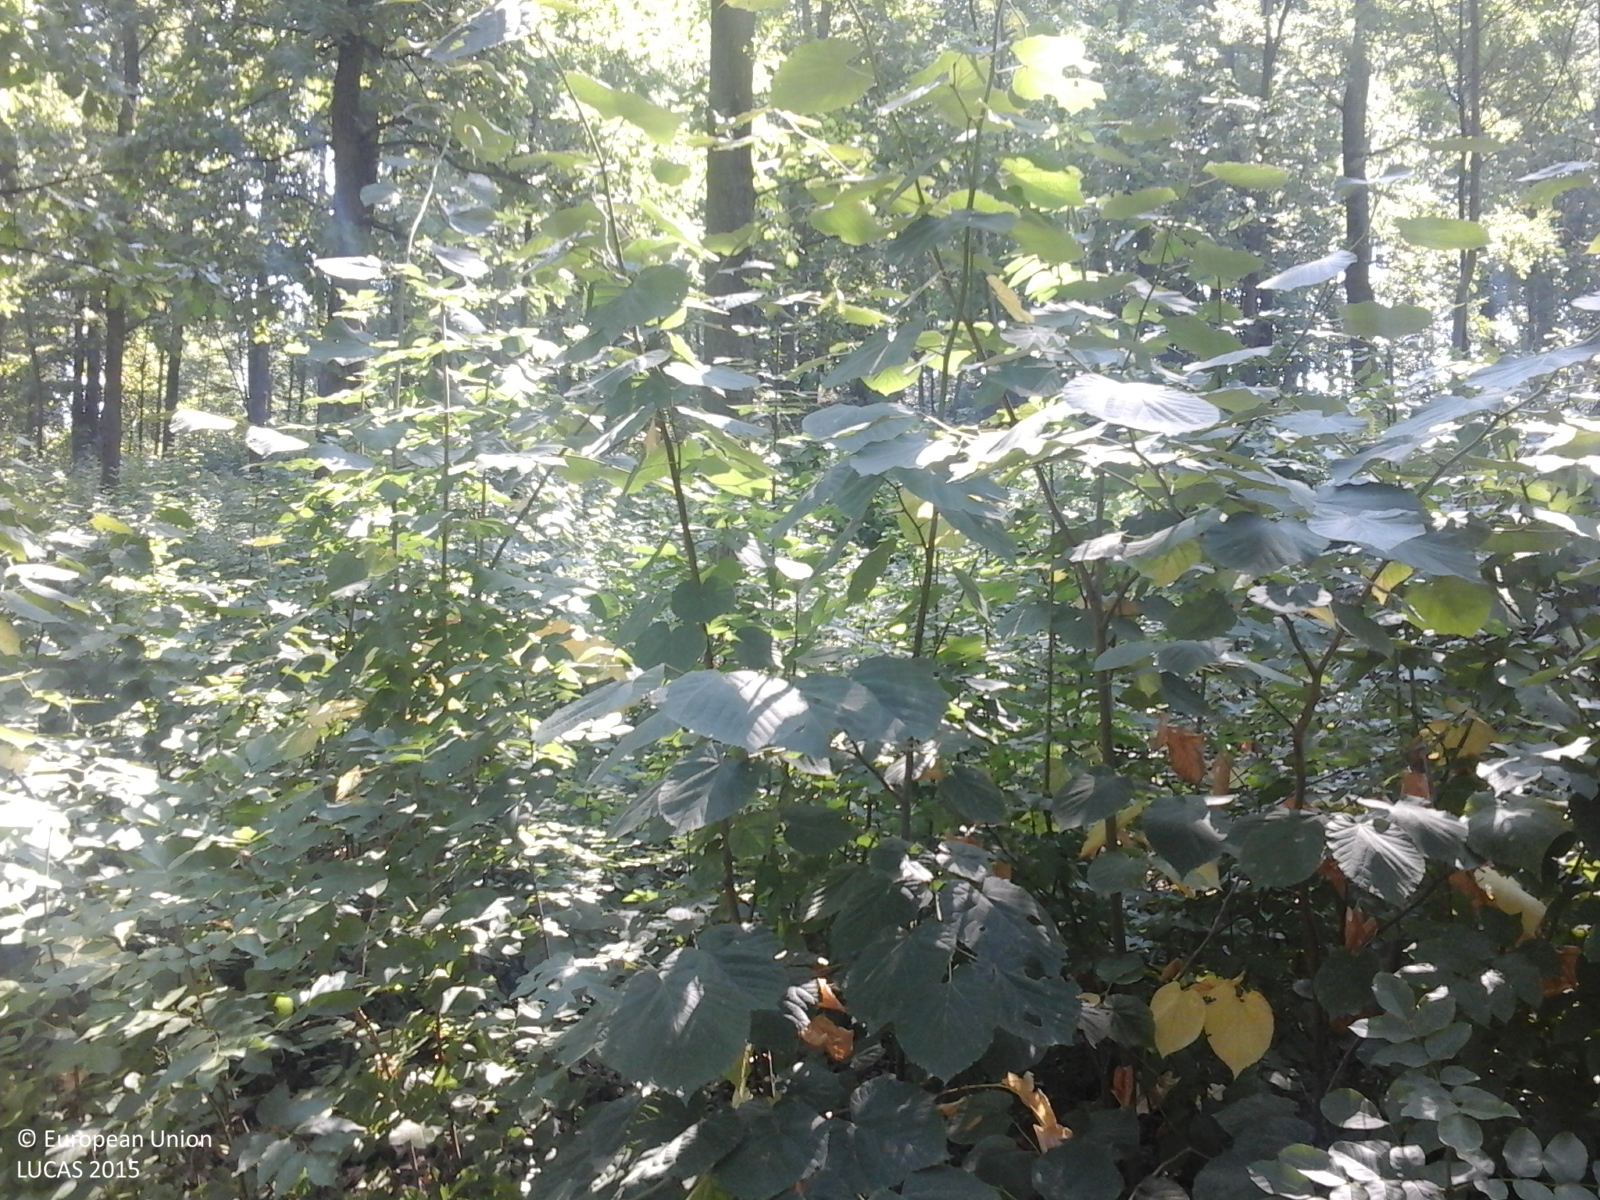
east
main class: Woodland
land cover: Broadleaved woodland
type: acidophilous oak and oak-birch forest
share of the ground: > 75 %
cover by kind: broadleaved forest trees 100 %
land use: Forestry
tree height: > 5 m
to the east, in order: Broadleaved woodland; Tracks; Broadleaved woodland
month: August
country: RO
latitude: 44.5497
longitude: 23.1520
